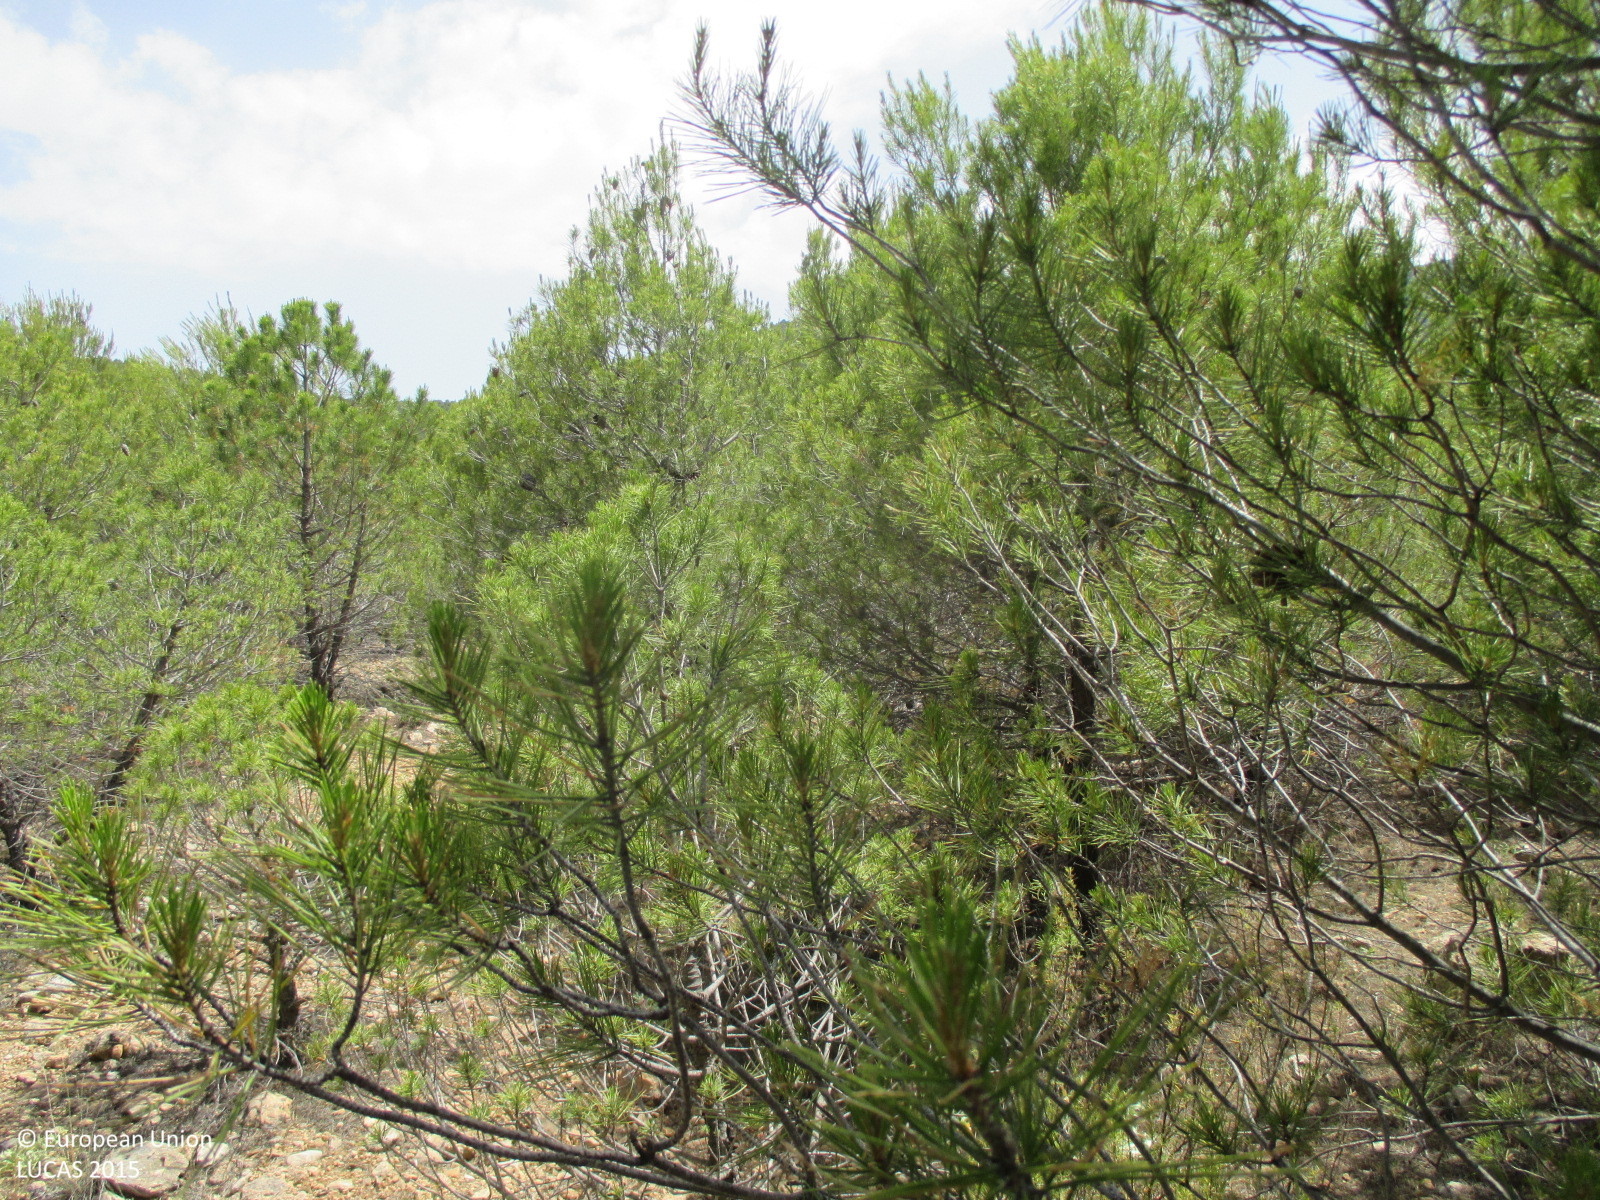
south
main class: Woodland
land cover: Pine dominated coniferous woodland
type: coniferous forest of the mediterranean region
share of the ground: > 75 %
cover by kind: coniferous forest trees 90 %, unconsolidated bare surface 10 %
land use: Forestry
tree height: < 5 m
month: June
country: ES
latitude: 37.6655
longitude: -2.4004
